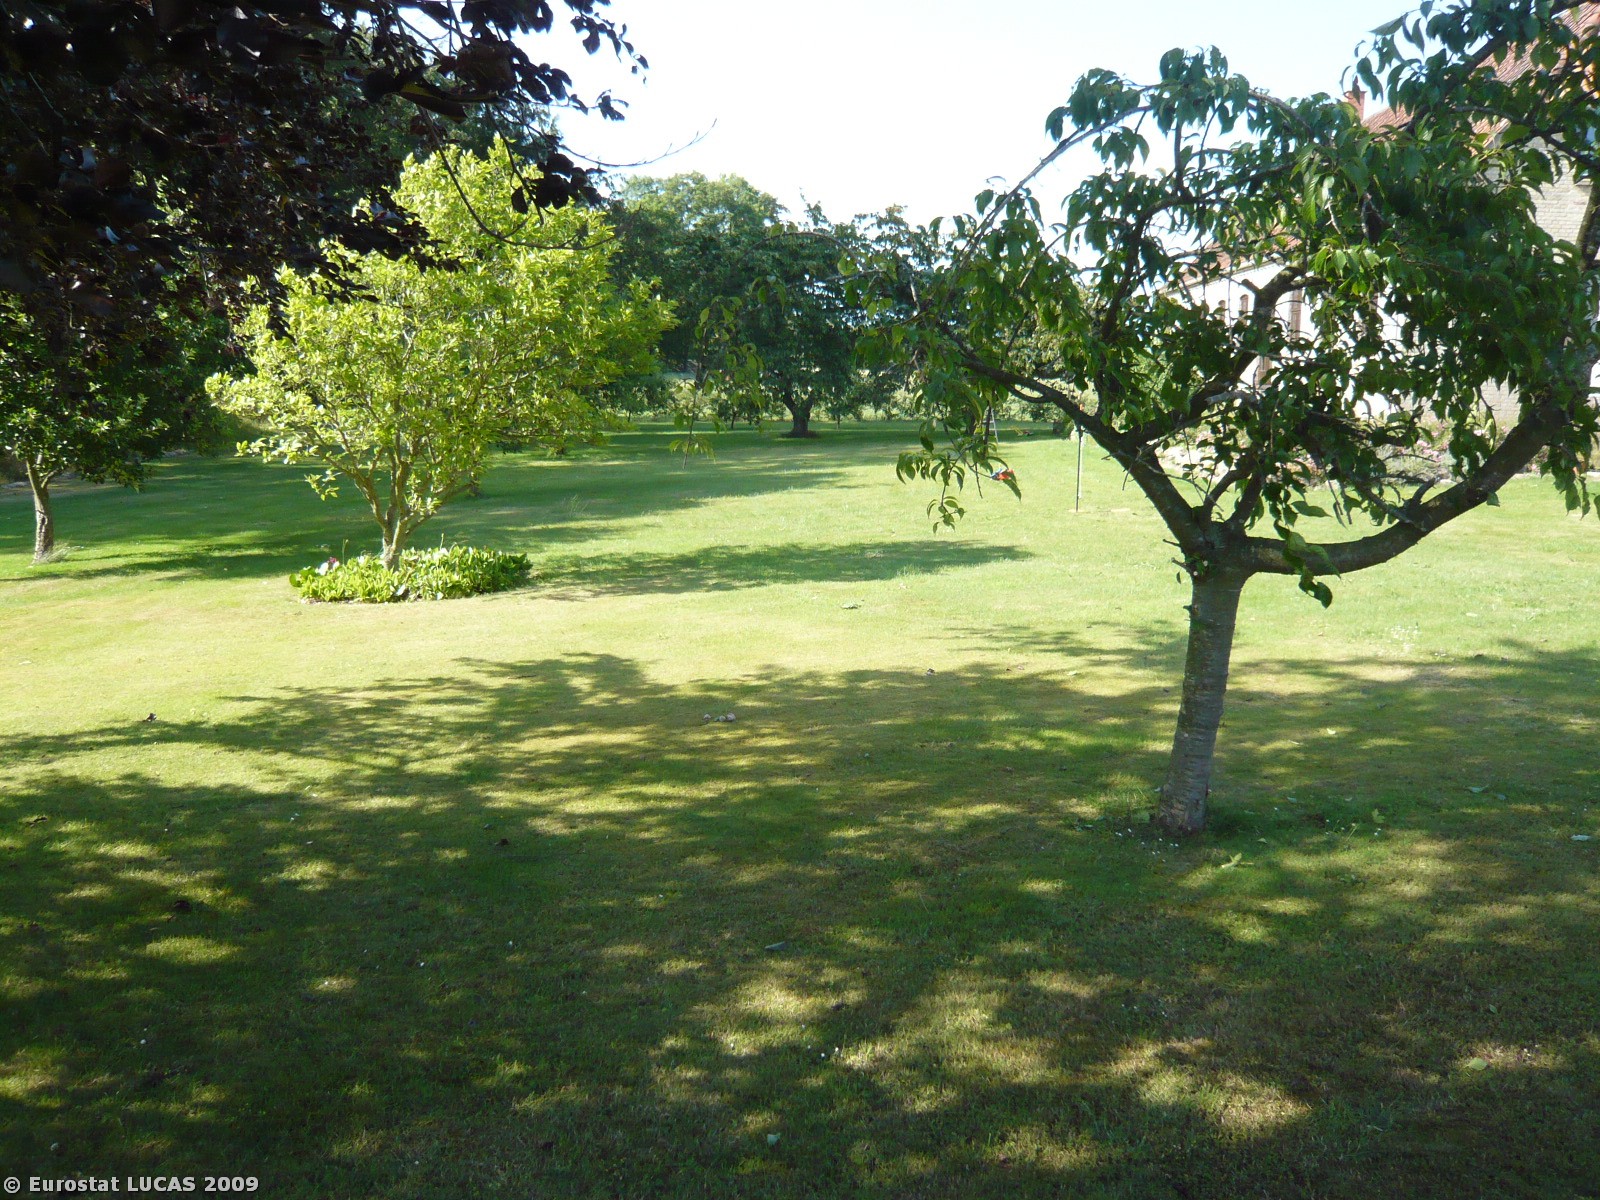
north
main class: Grassland
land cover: Grassland without tree/shrub cover
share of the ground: > 75 %
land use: Residential
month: July
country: DK
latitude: 55.3233
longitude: 10.6456
